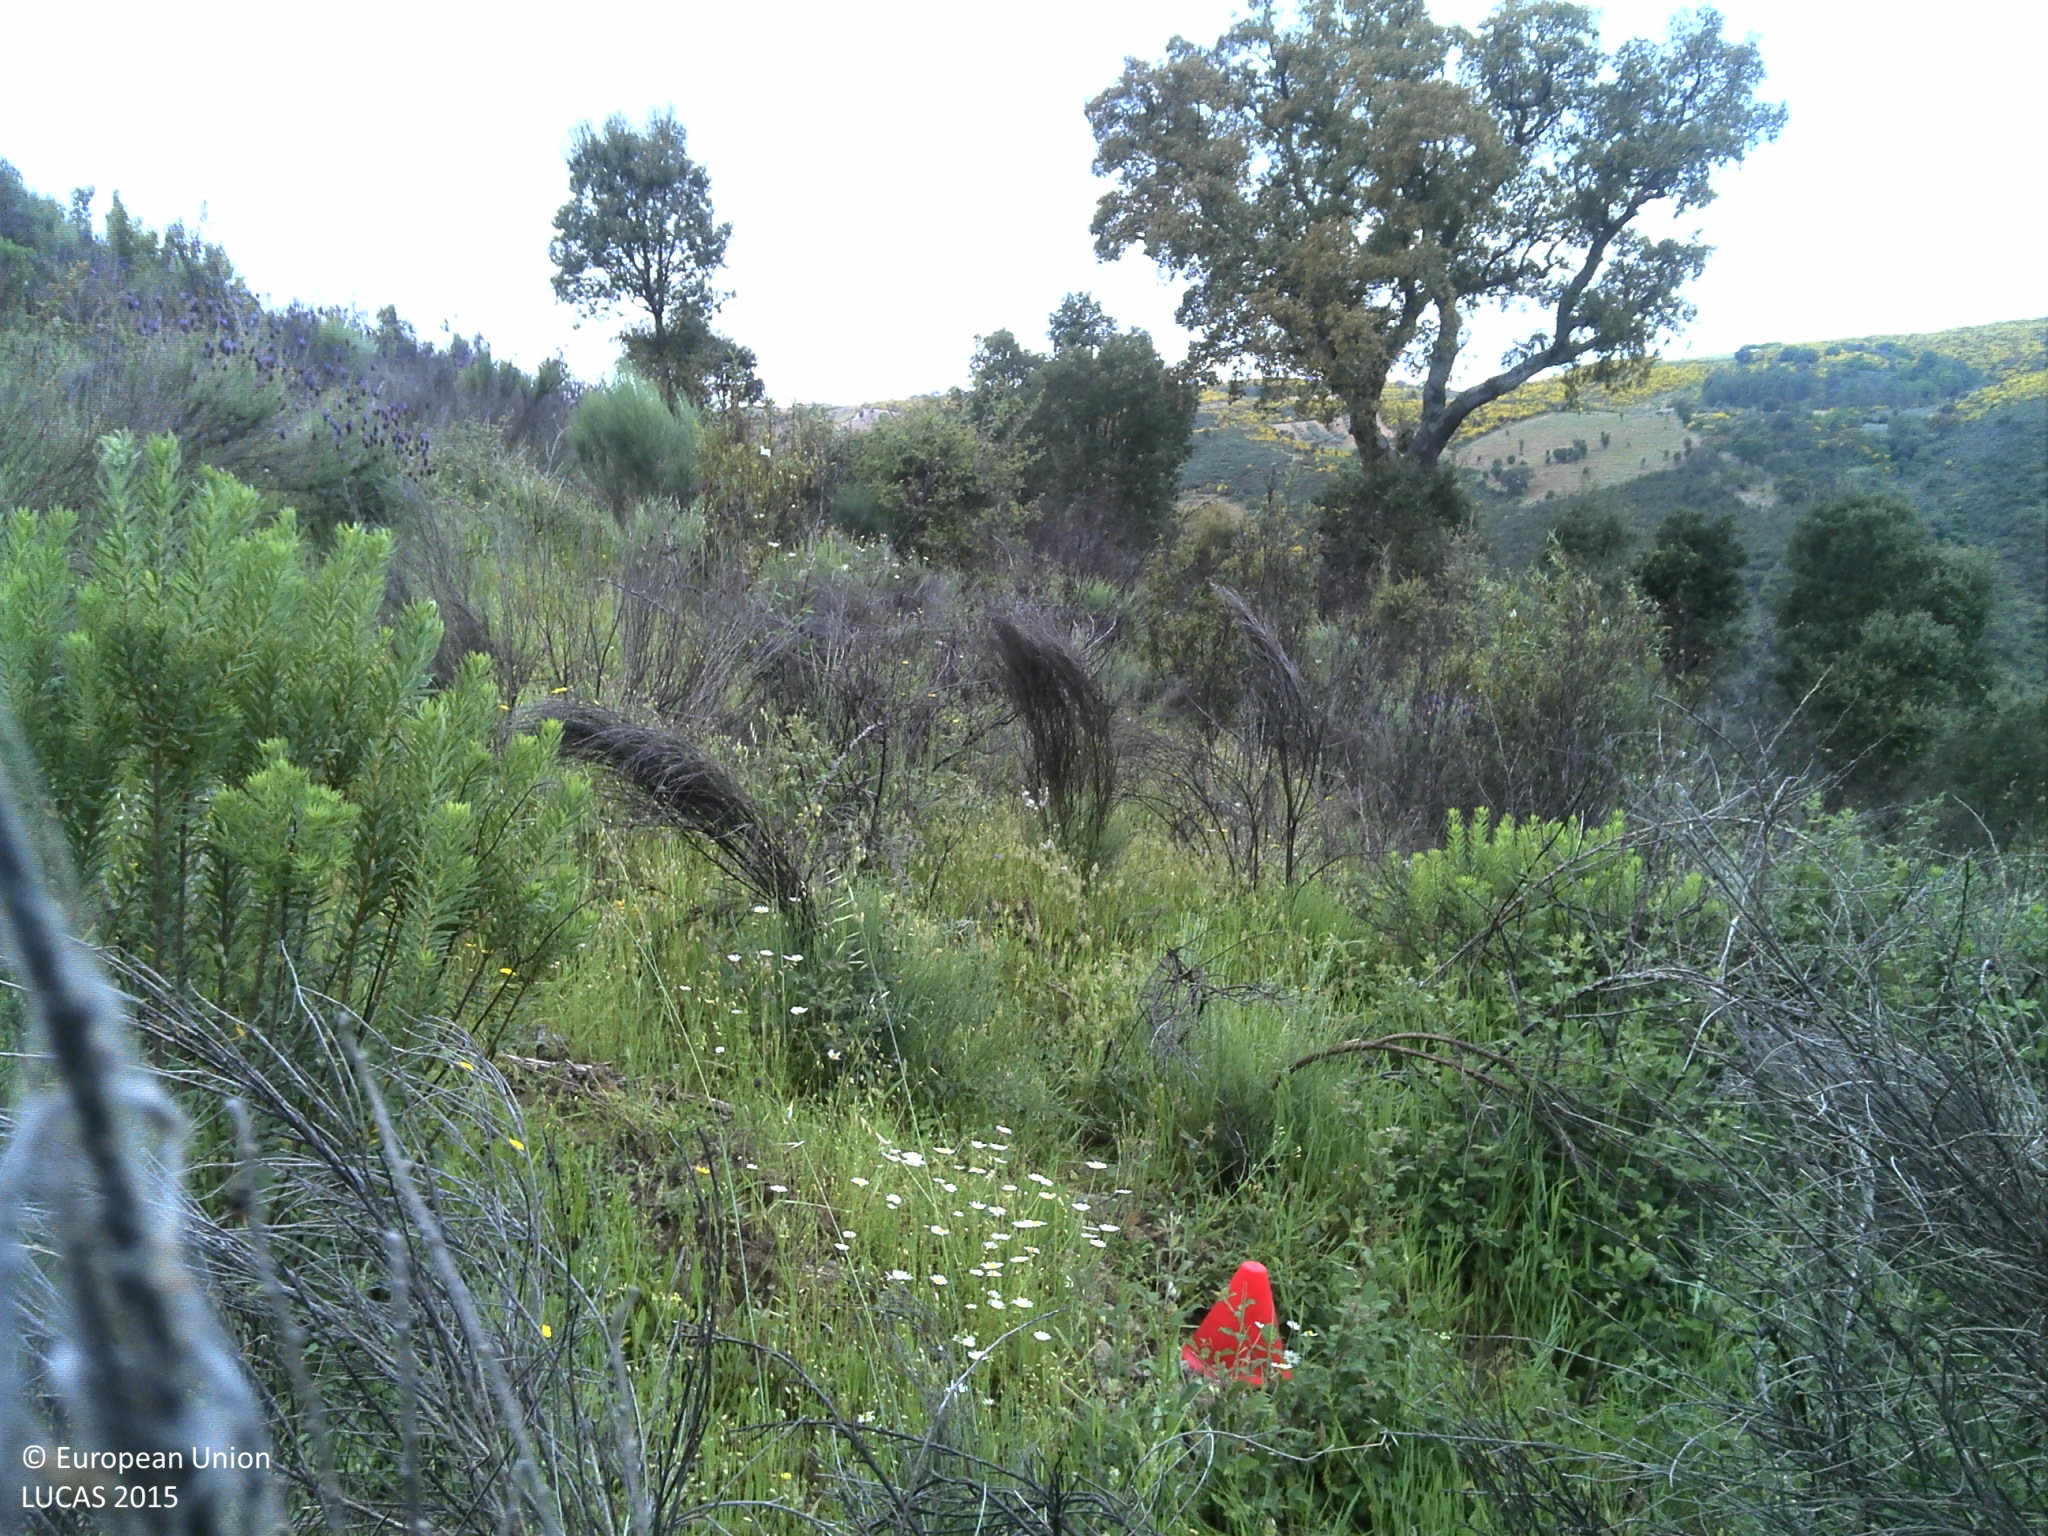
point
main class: Shrubland
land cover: Shrubland with sparse tree cover
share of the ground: 50 - 75 %
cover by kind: shrubs 75 %, herbaceous plants 15 %, broadleaved forest trees 5 %, unconsolidated bare surface 5 %
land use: Semi-natural and natural areas not in use
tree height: > 5 m
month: May
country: PT
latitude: 41.6232
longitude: -7.0283
